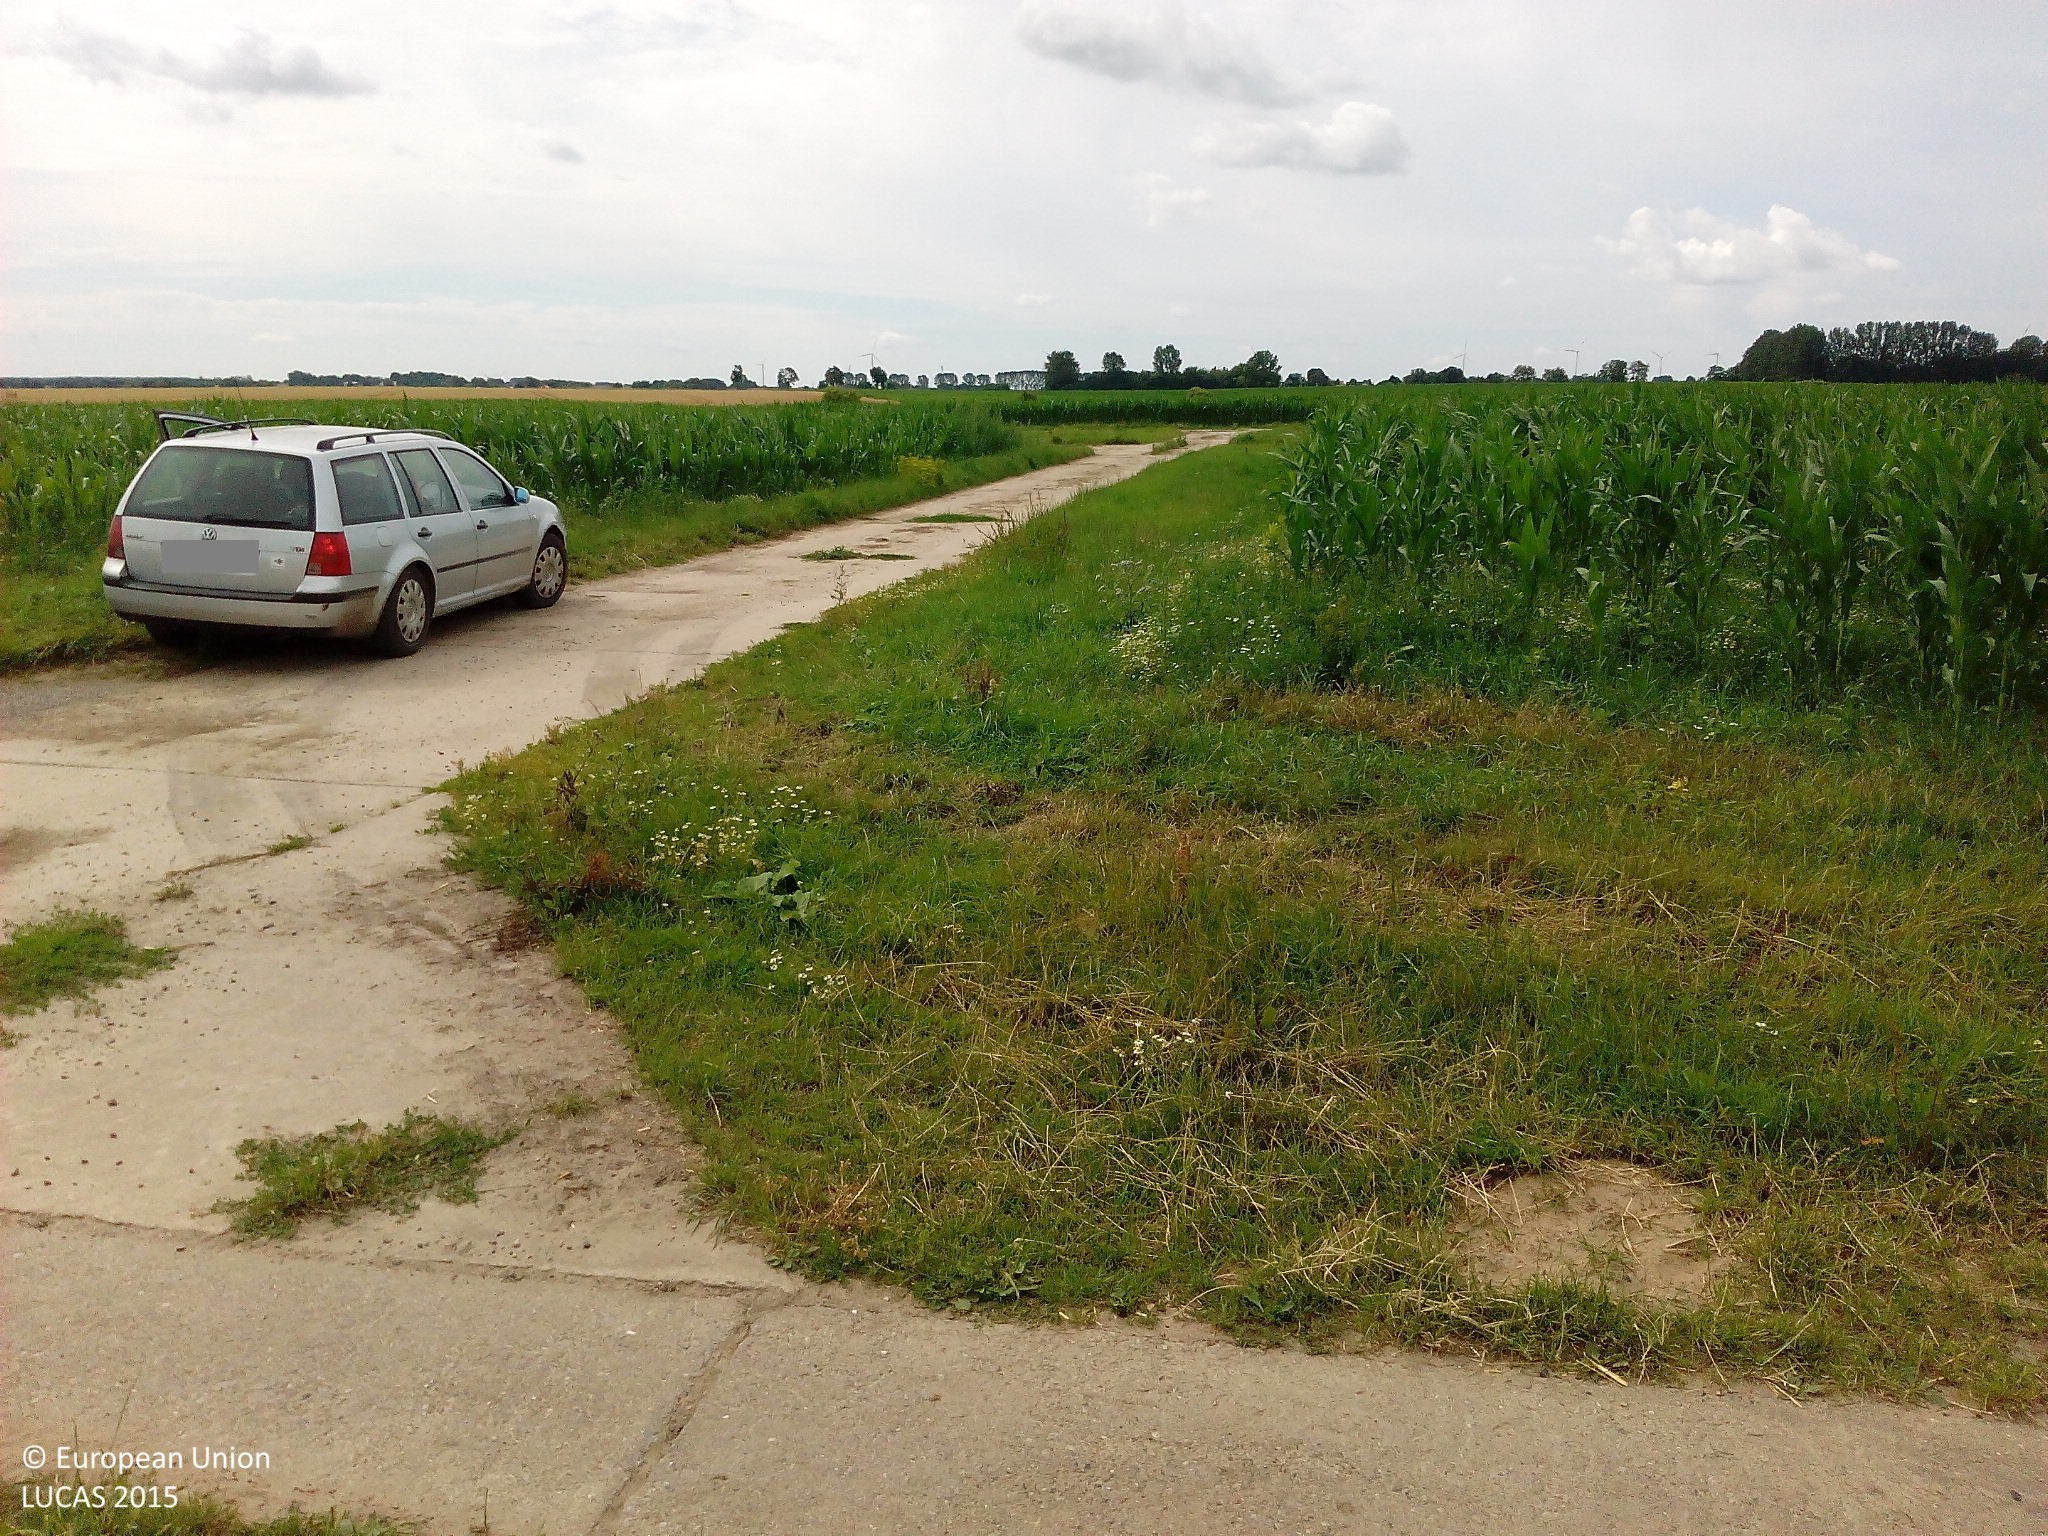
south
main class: Grassland
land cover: Grassland without tree/shrub cover
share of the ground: > 75 %
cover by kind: herbaceous plants 100 %
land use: Agriculture (excluding fallow land and kitchen gardens)
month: July
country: DE
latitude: 54.0949
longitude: 13.2868
